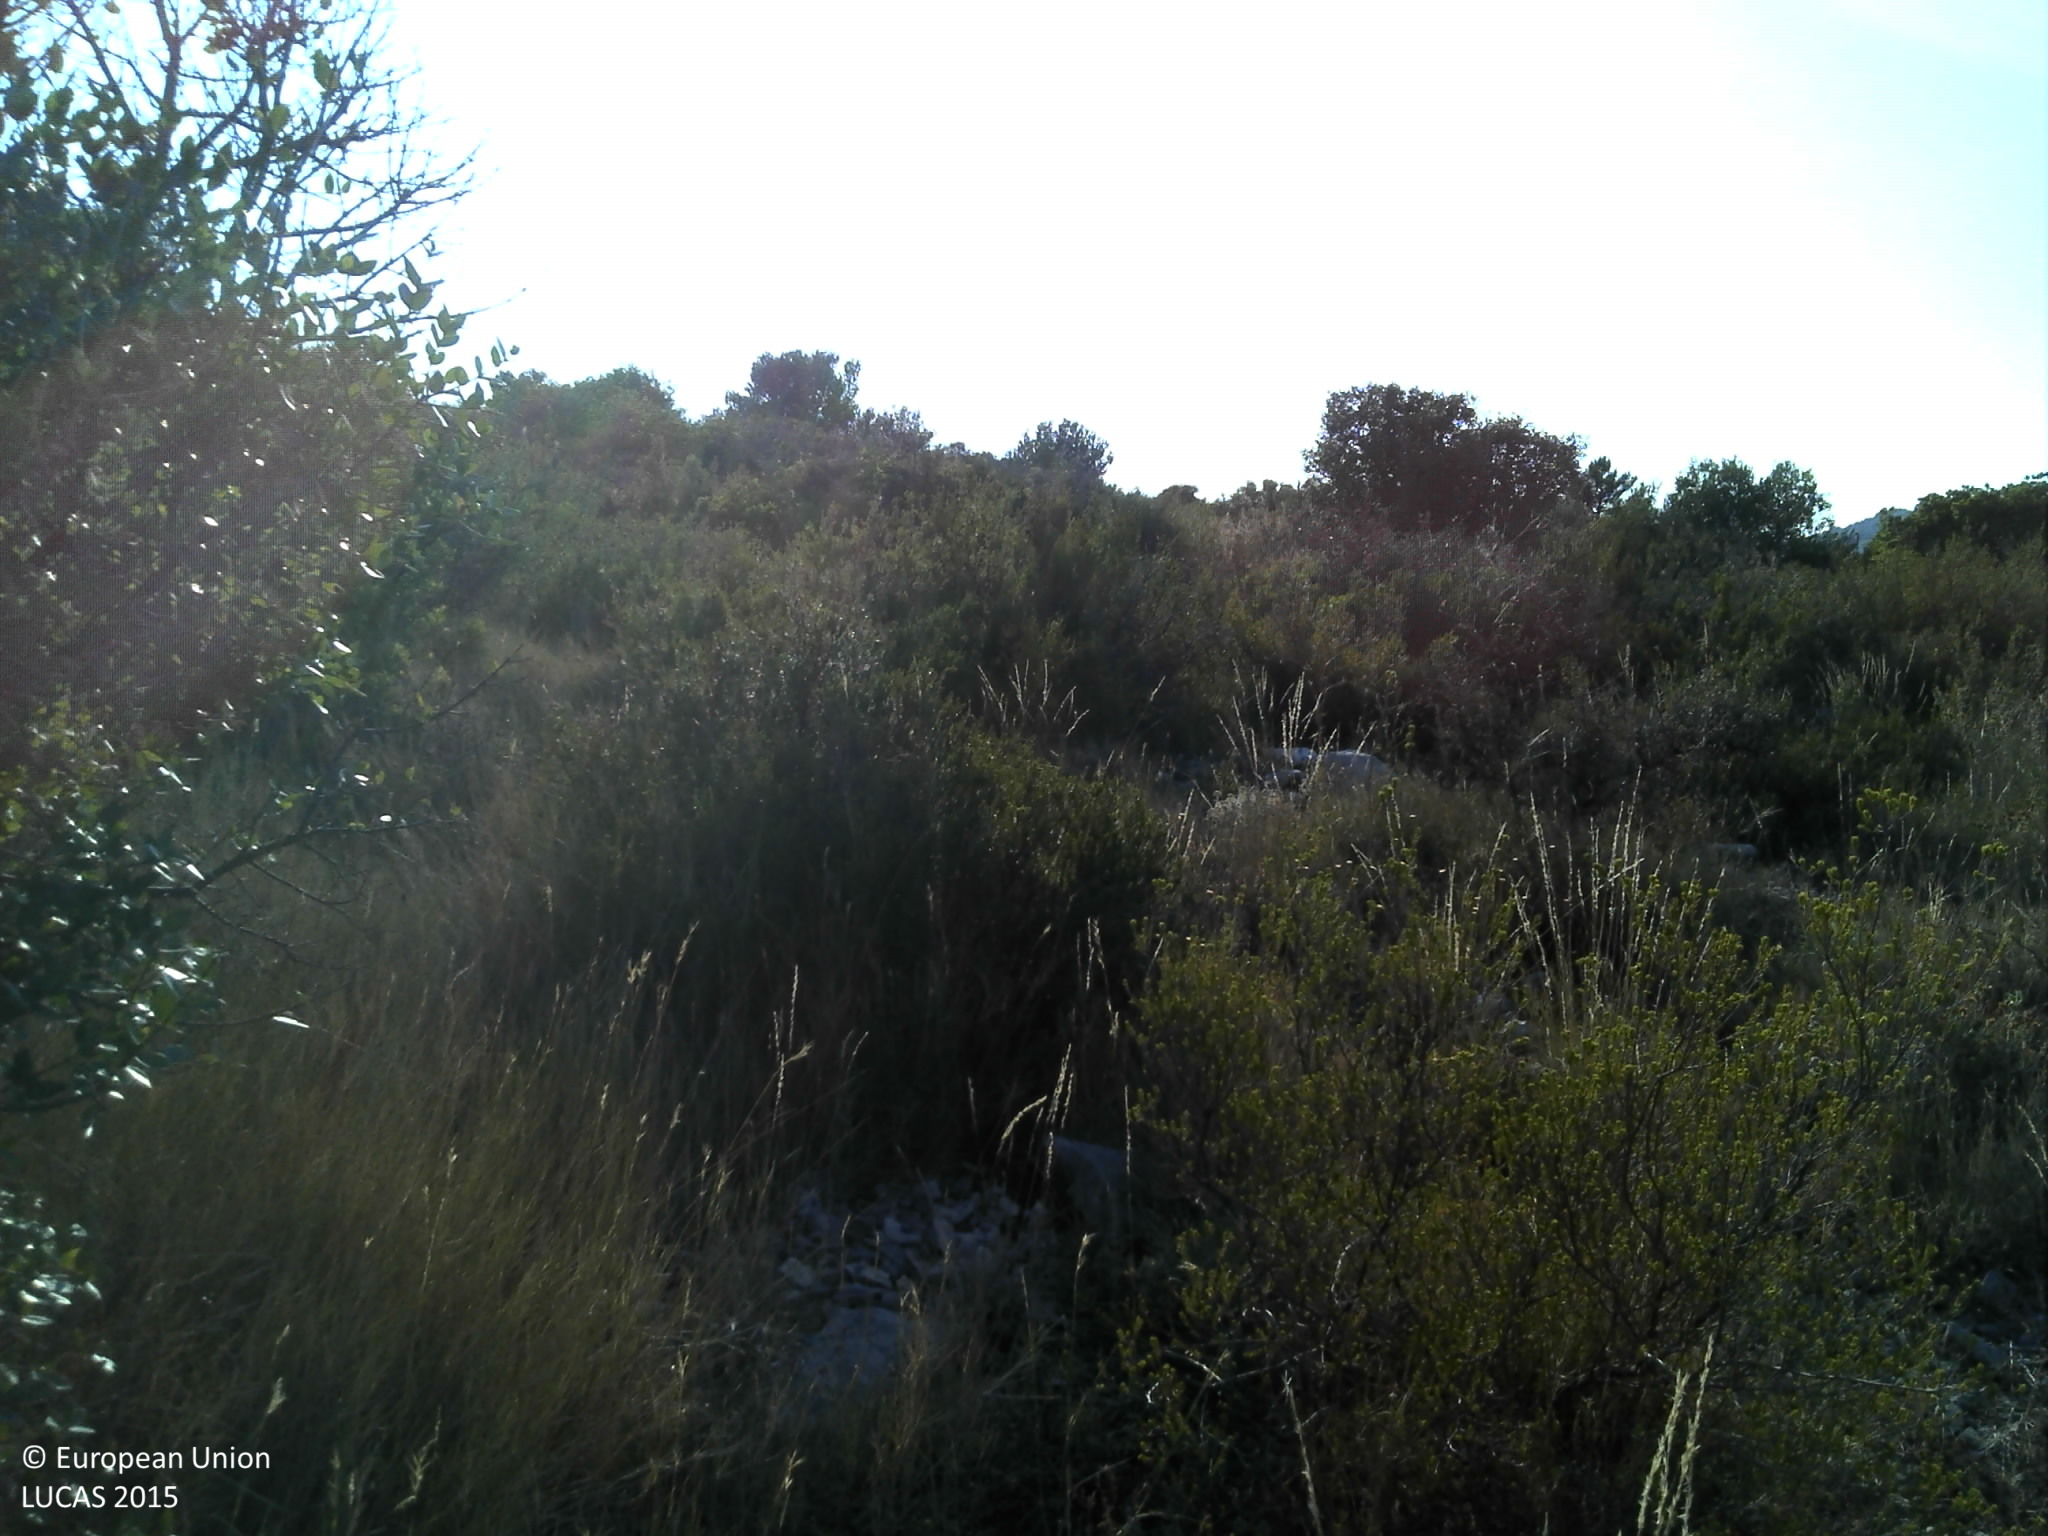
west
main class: Shrubland
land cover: Shrubland without tree cover
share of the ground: 50 - 75 %
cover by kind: shrubs 50 %, herbaceous plants 25 %, unconsolidated bare surface 15 %, consolidated bare surface 10 %
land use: Semi-natural and natural areas not in use
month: July
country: HR
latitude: 42.6754
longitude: 18.0807
